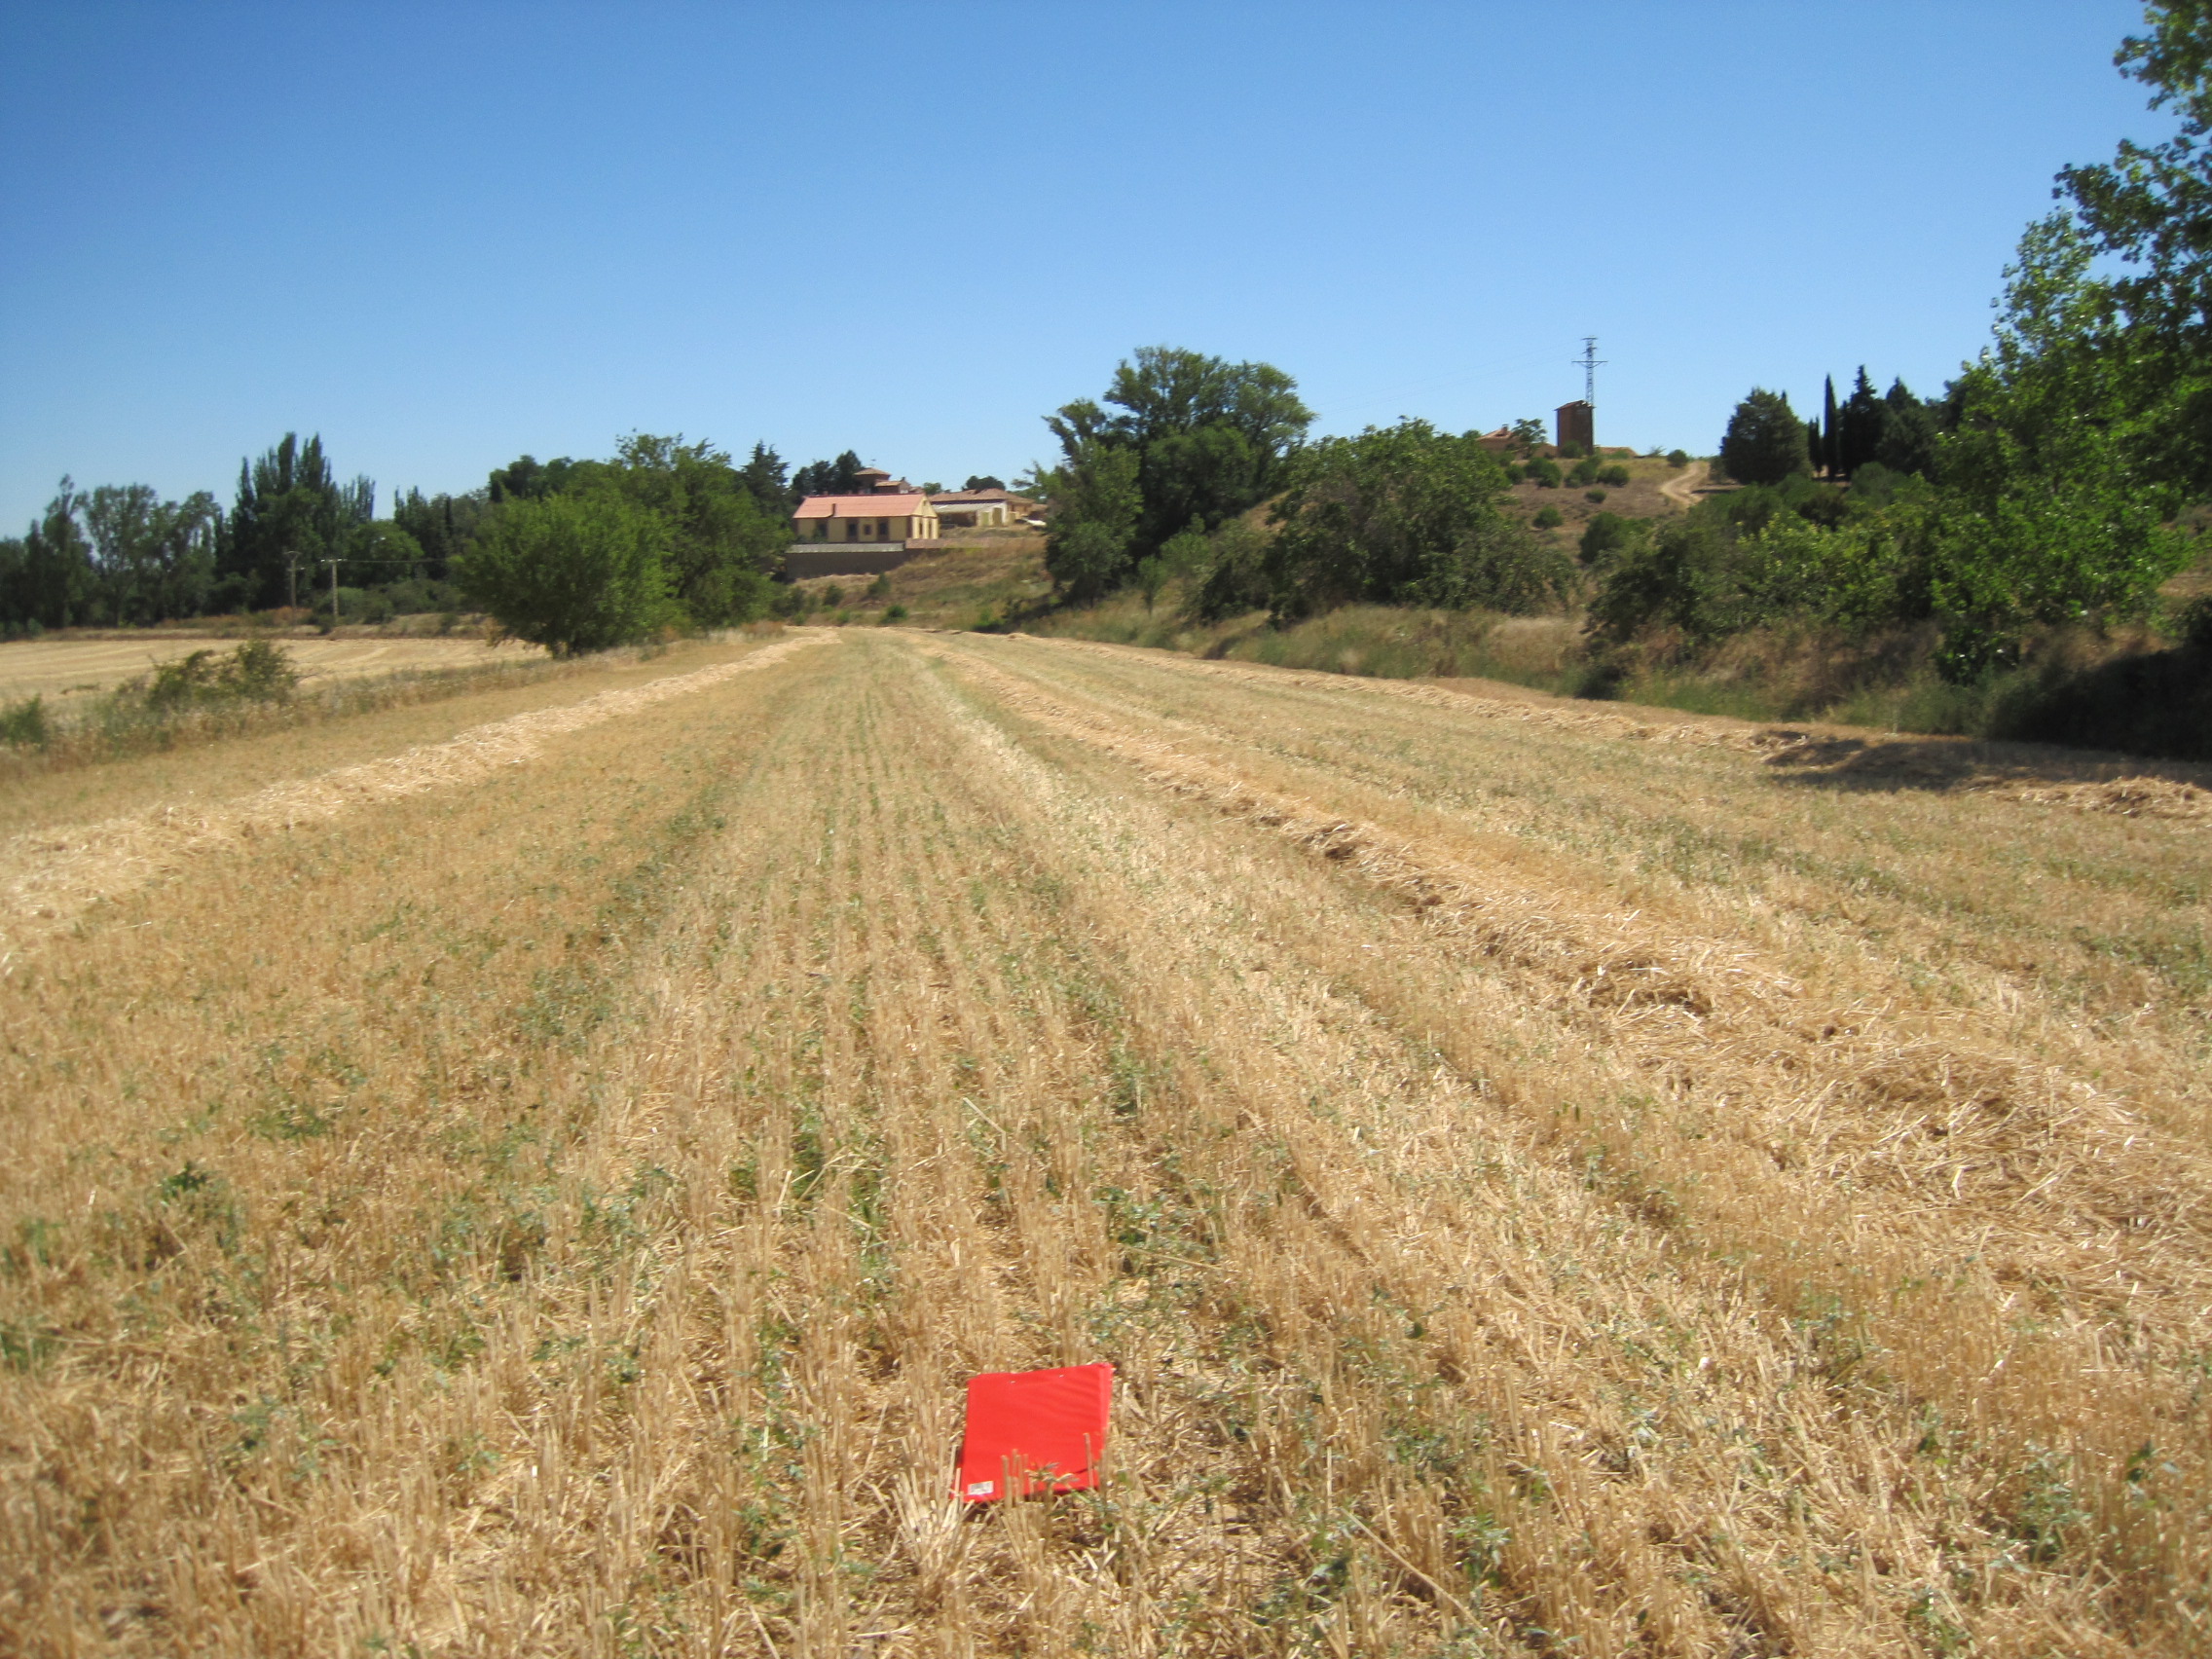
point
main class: Cropland
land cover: Common wheat
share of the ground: < 10 %
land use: Agriculture (excluding fallow land and kitchen gardens)
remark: Harvested field
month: July
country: ES
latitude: 42.1448
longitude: -5.2960
